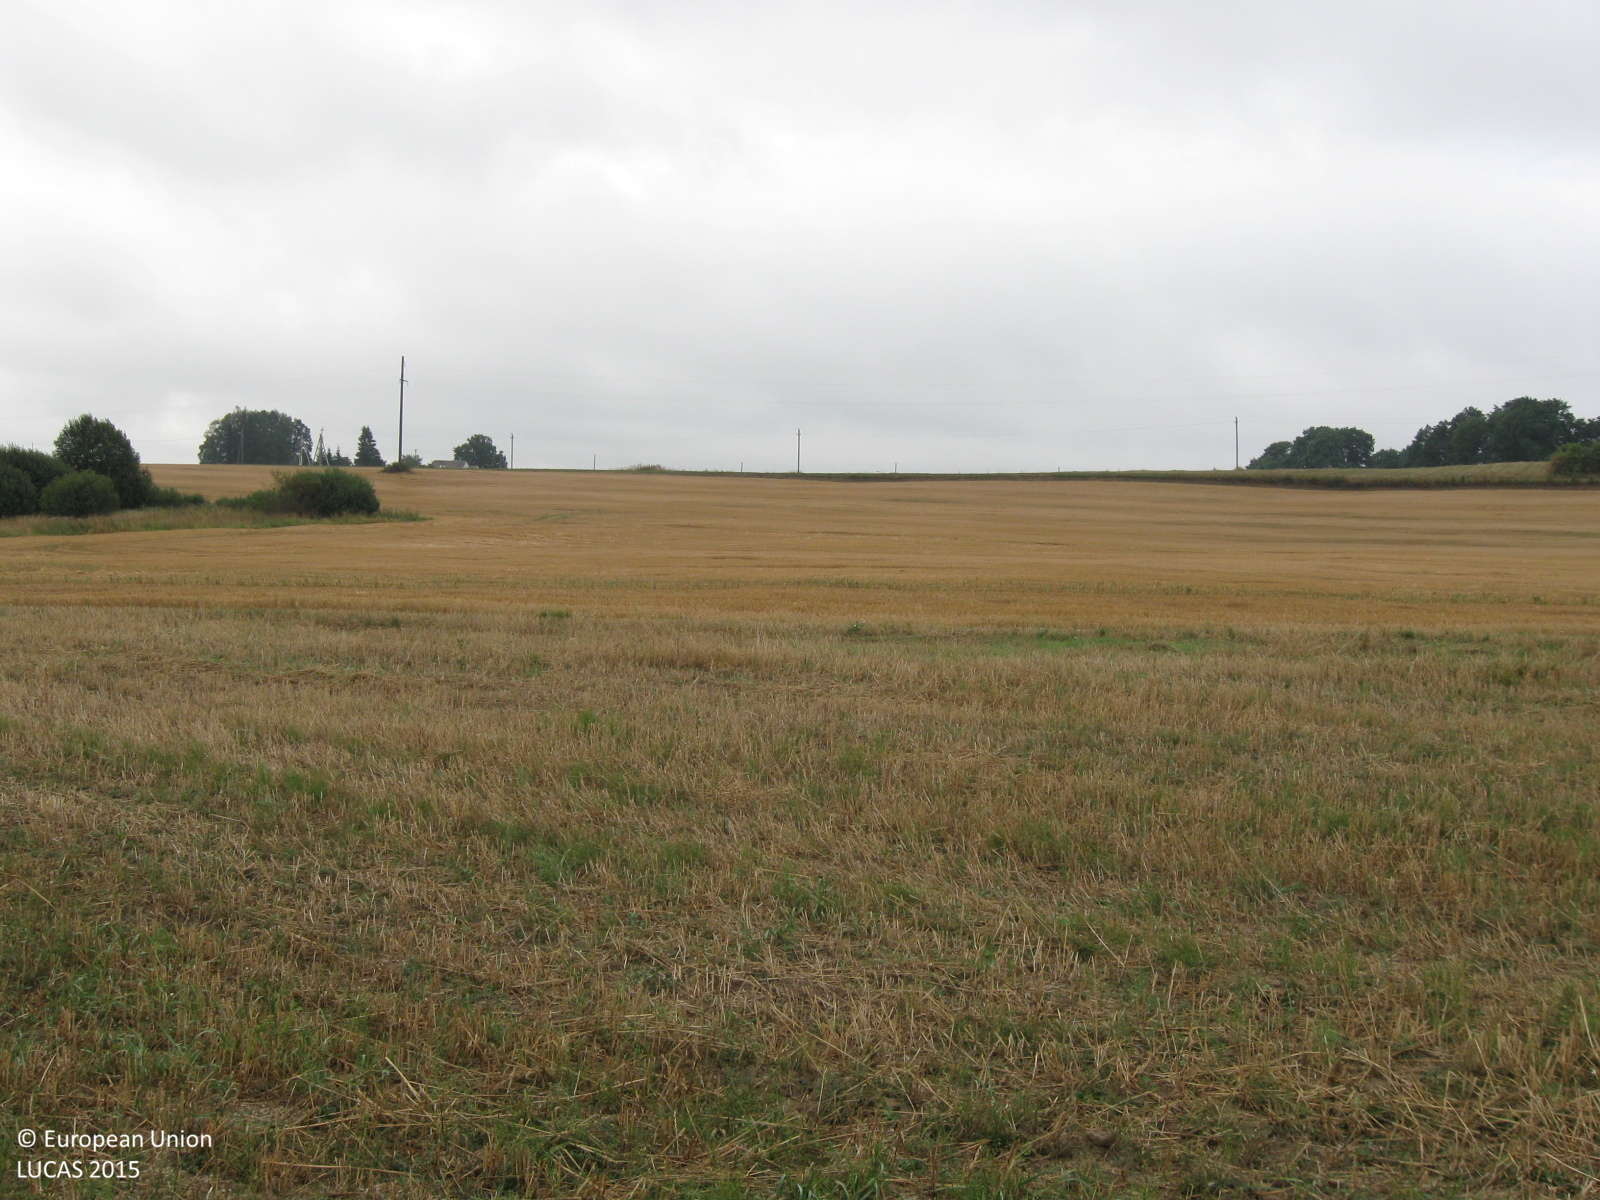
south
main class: Cropland
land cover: Common wheat
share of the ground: > 75 %
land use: Agriculture (excluding fallow land and kitchen gardens)
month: August
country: LT
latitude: 55.3656
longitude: 23.2806
